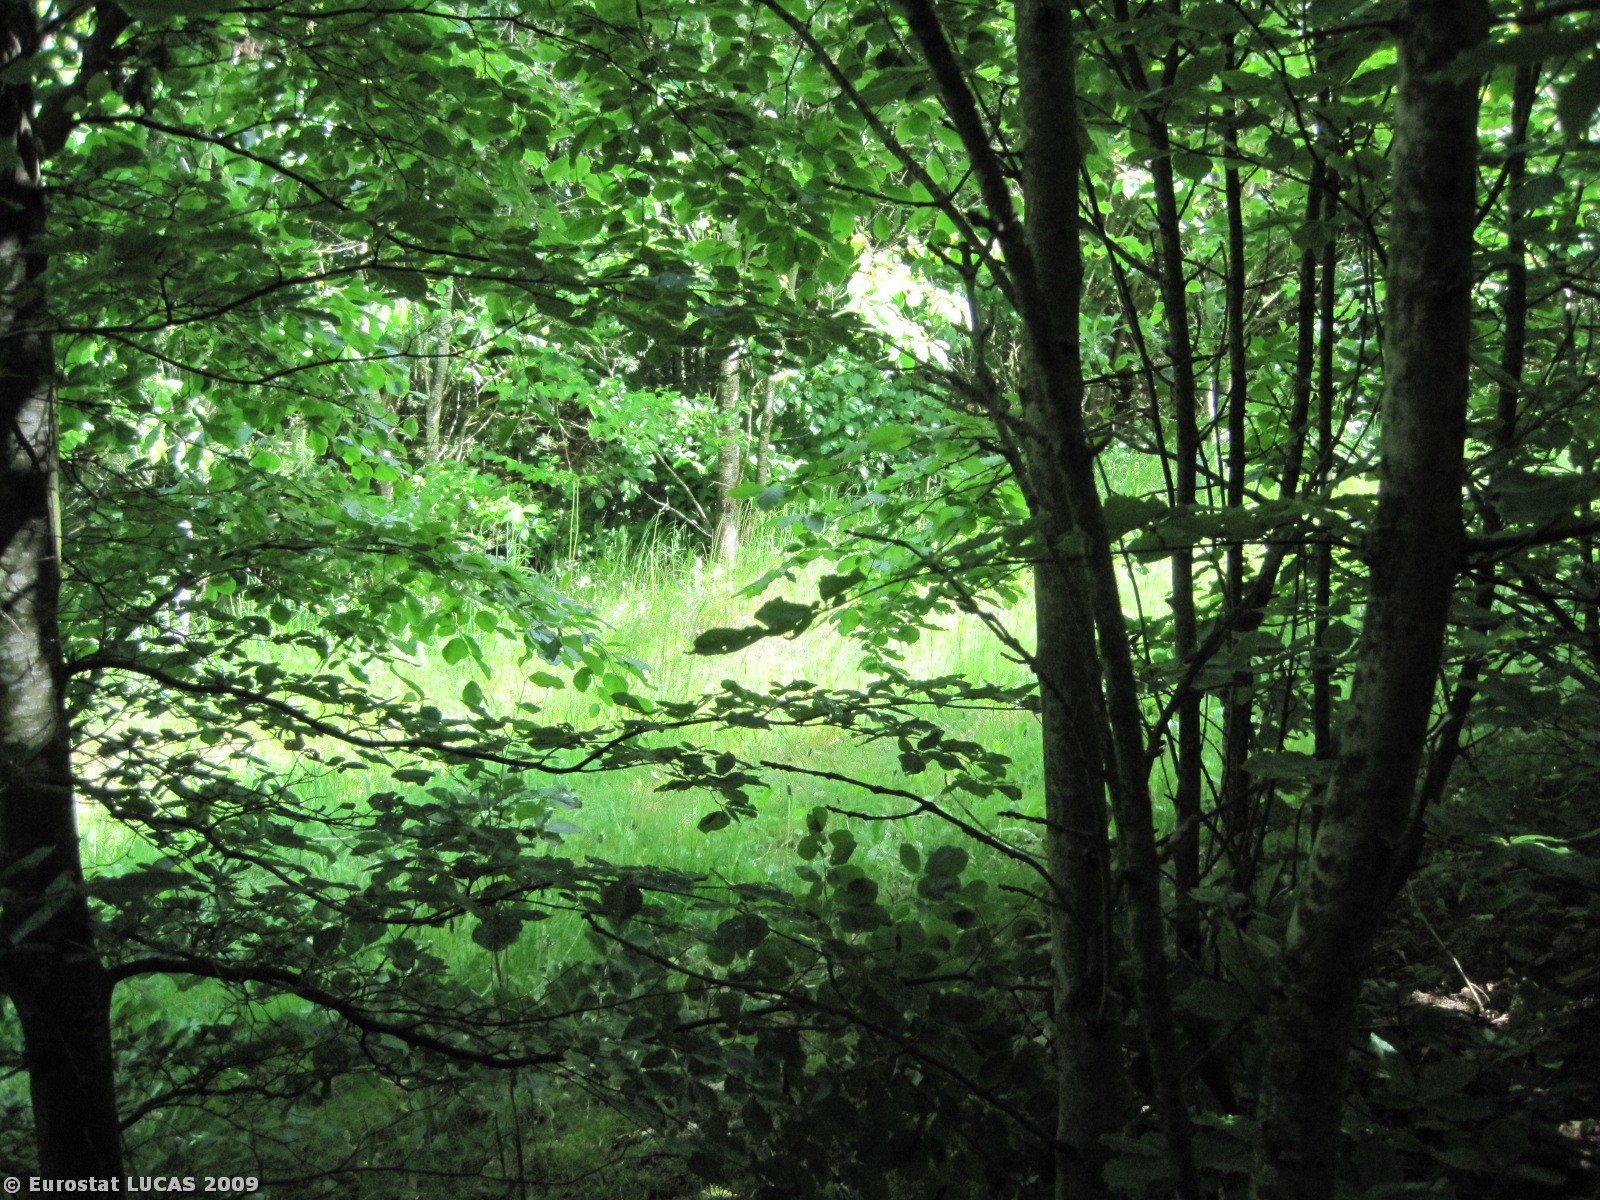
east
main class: Woodland
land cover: Broadleaved woodland
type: beech forest
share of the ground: > 75 %
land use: Forestry
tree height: > 5 m
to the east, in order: Broadleaved woodland; Tracks; Broadleaved woodland; Grassland without tree/shrub cover; Paved roads, cycling and walking lanes; Grassland without tree/shrub cover; Single bushes/trees; Grassland without tree/shrub cover; Broadleaved woodland; Coniferous woodland; Broadleaved woodland; Grassland without tree/shrub cover; Coniferous woodland; Grassland without tree/shrub cover
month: May
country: DK
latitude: 56.5830
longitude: 9.7886
